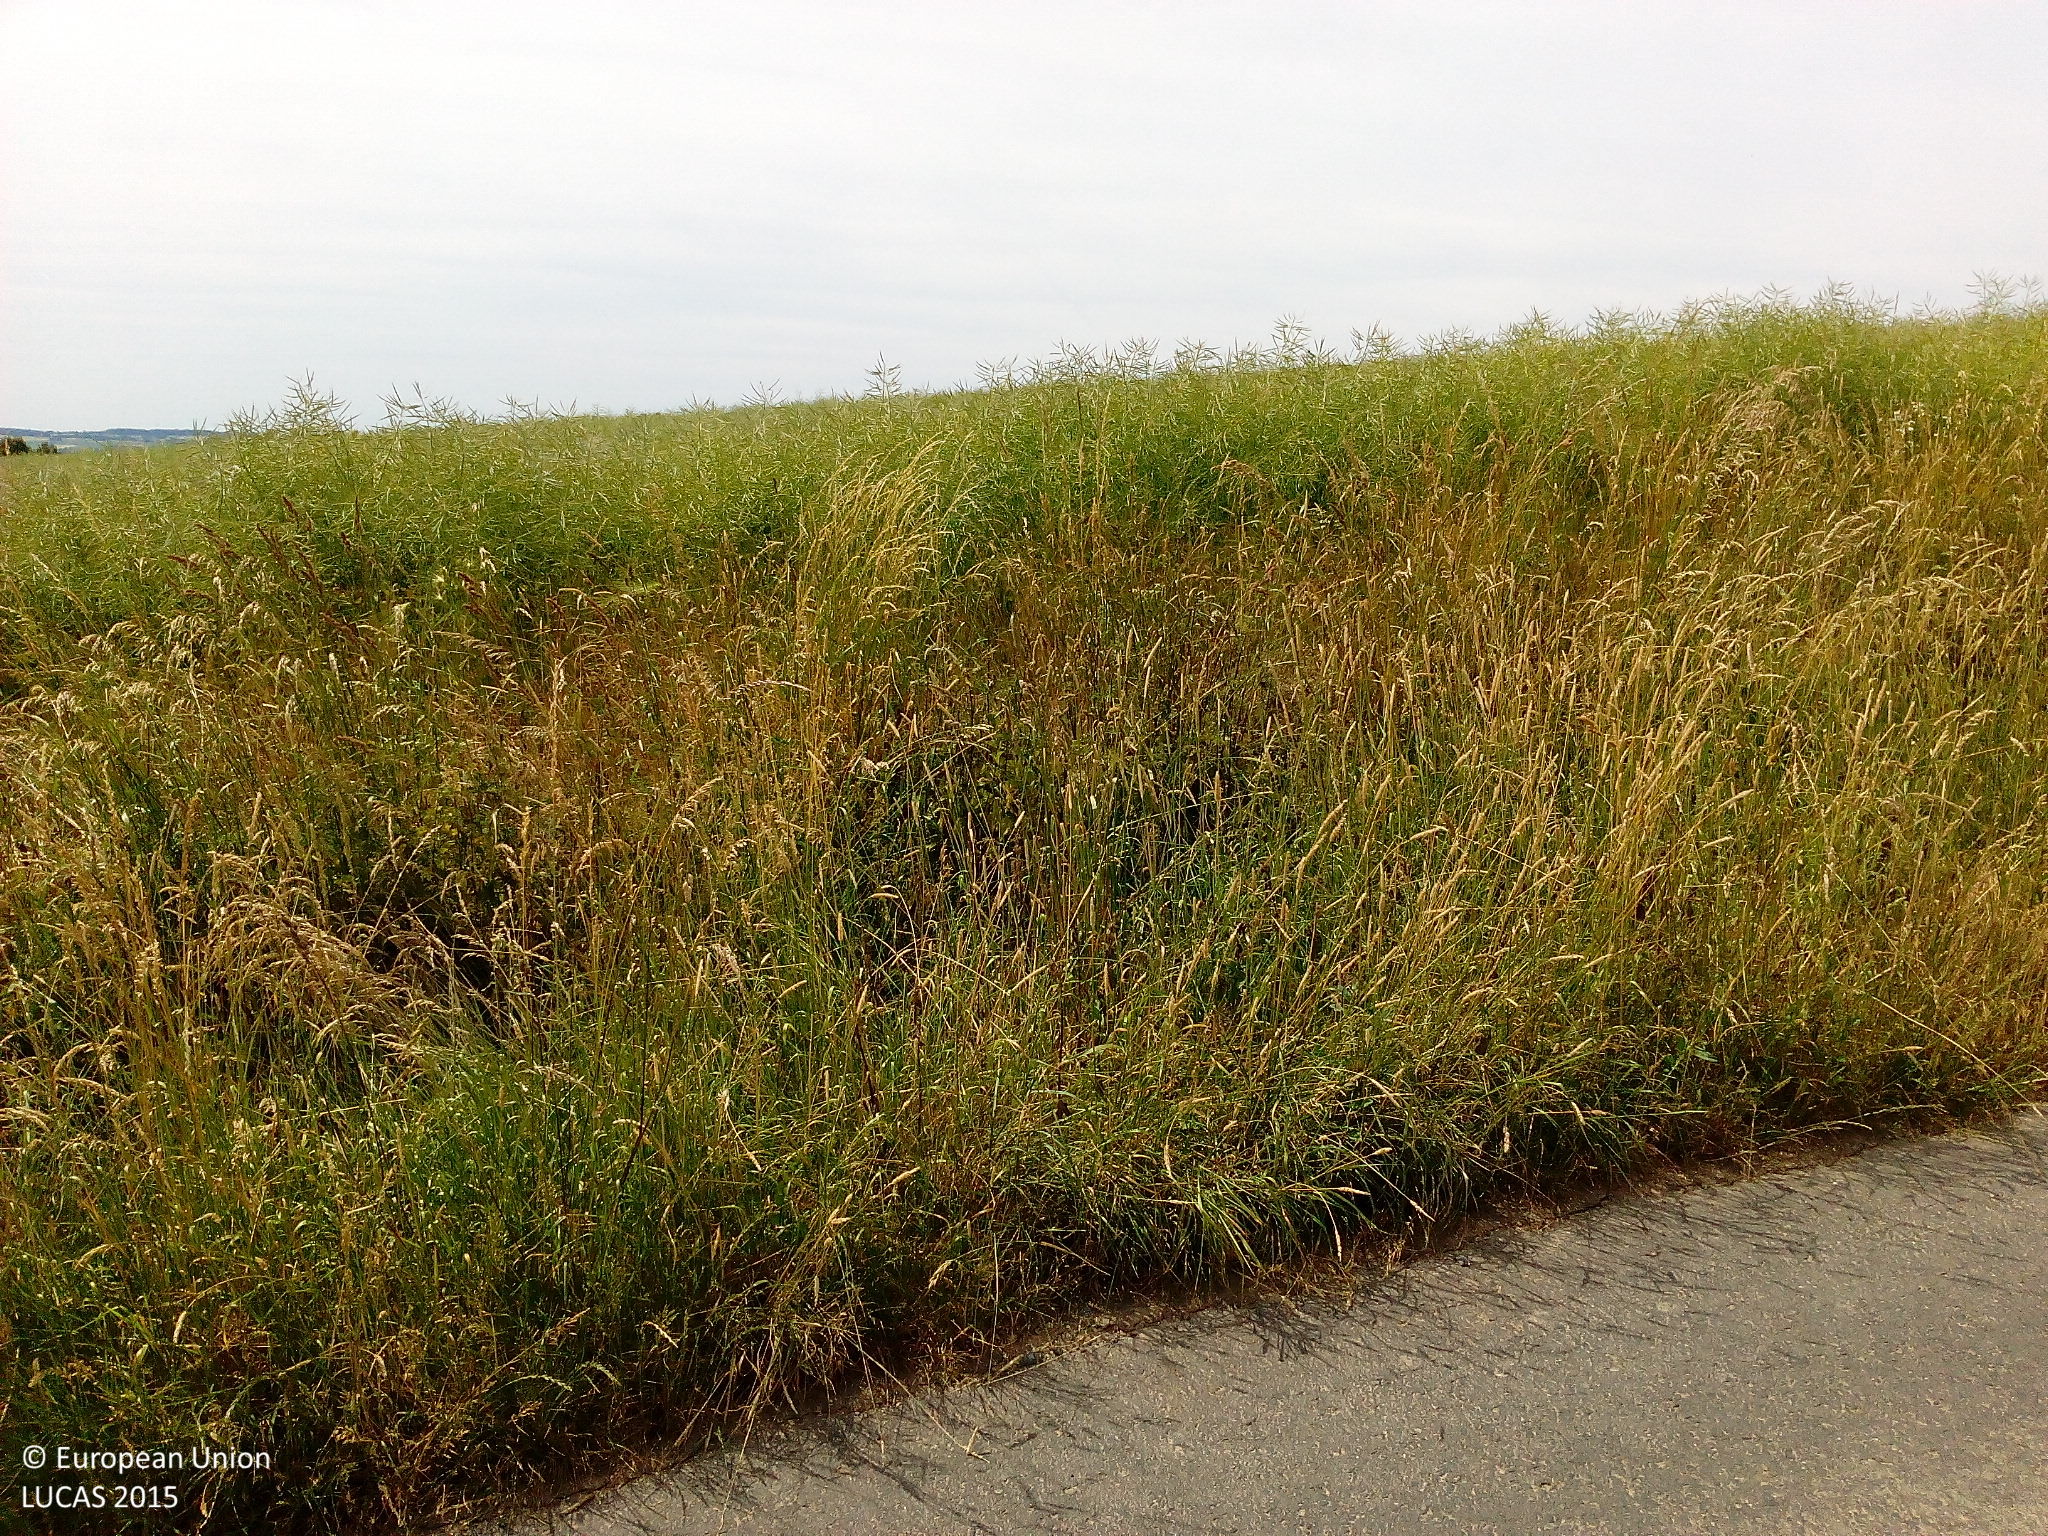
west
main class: Cropland
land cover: Barley
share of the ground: > 75 %
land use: Agriculture (excluding fallow land and kitchen gardens)
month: June
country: DE
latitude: 50.8834
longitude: 9.3037
